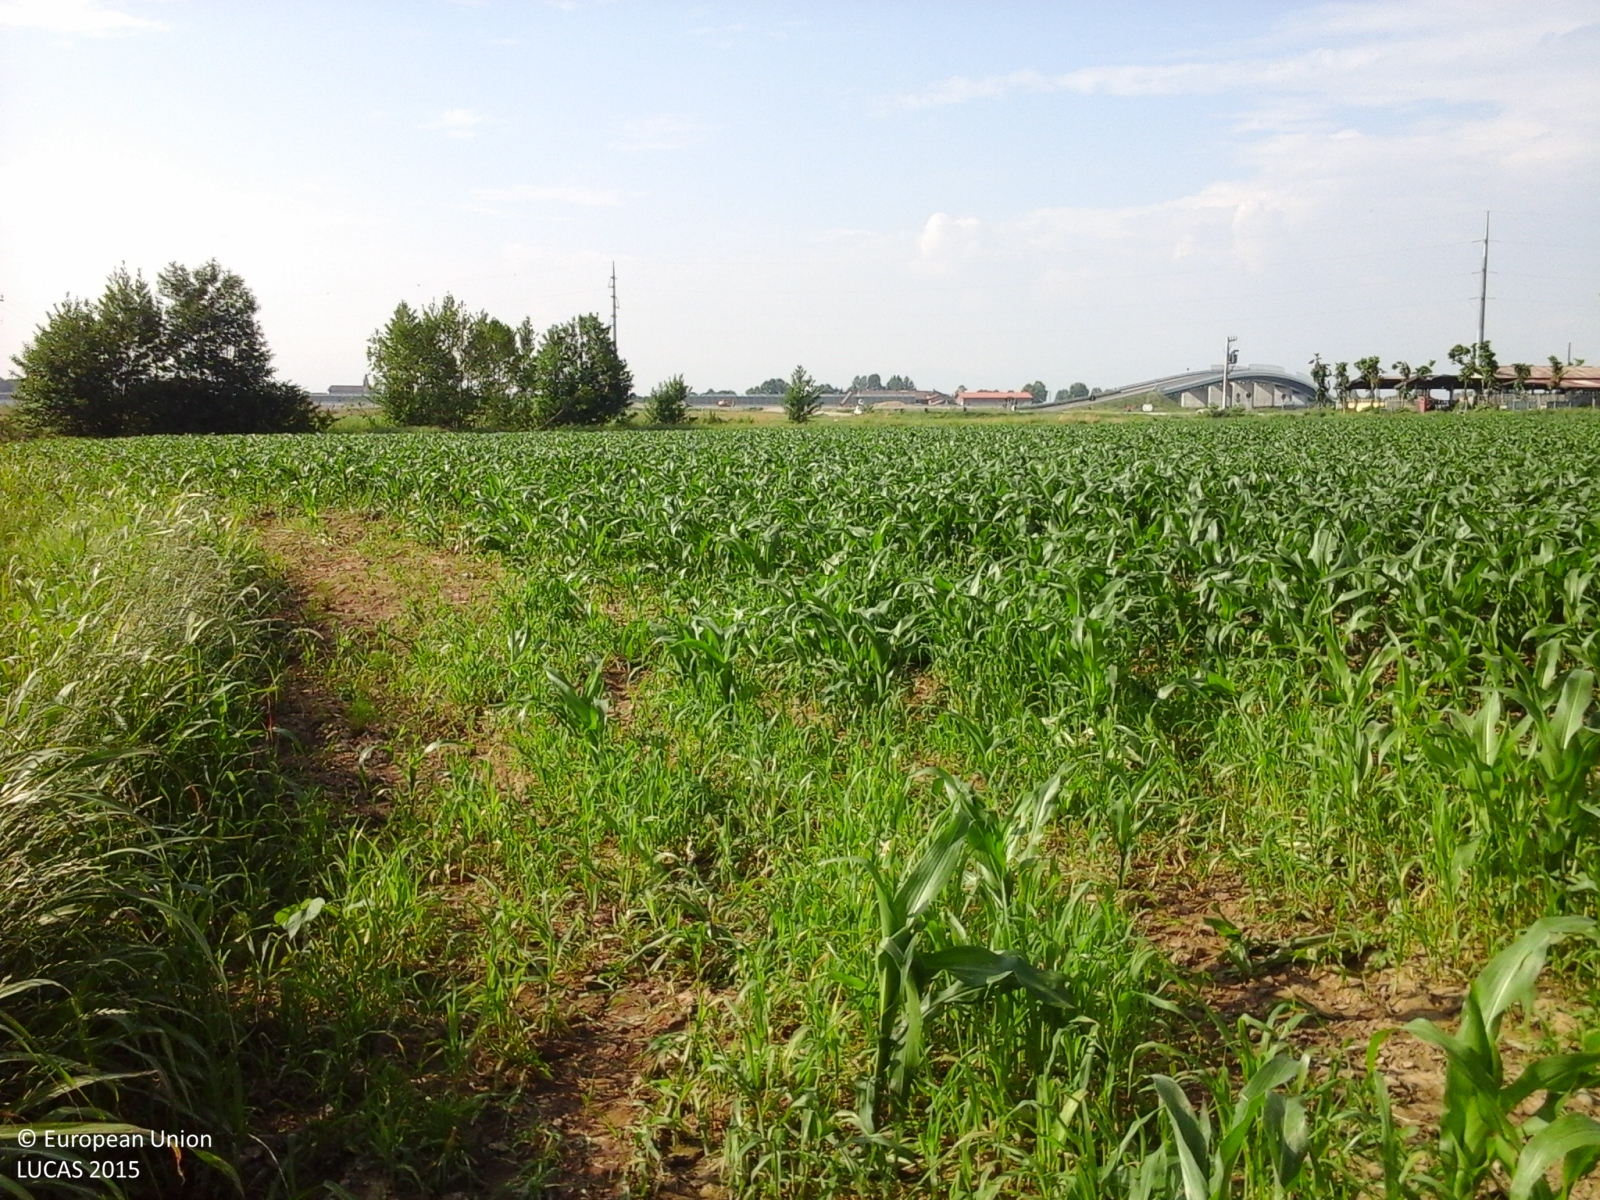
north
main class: Cropland
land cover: Lucerne
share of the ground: > 75 %
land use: Agriculture (excluding fallow land and kitchen gardens)
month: May
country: IT
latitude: 45.5039
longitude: 9.6806
